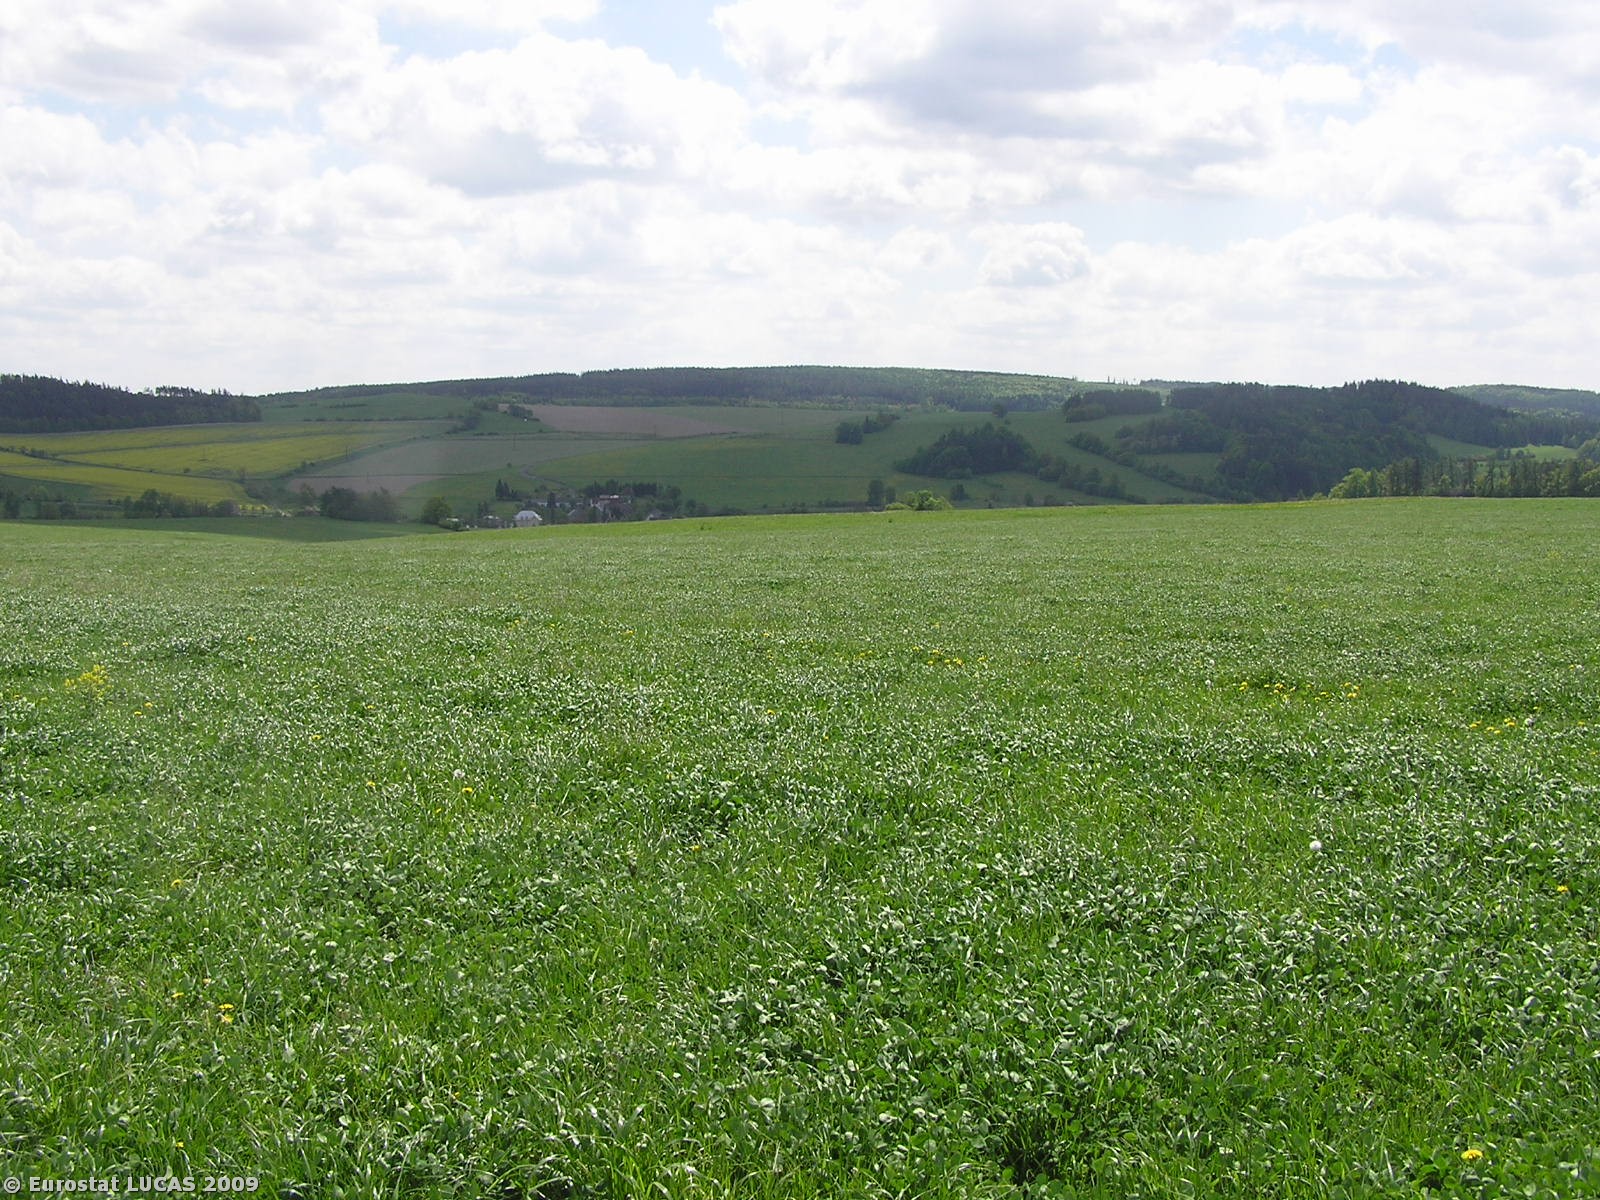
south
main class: Cropland
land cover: Clovers
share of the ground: > 75 %
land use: Agriculture (excluding fallow land and kitchen gardens)
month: May
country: CZ
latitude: 50.0194
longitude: 17.6195
